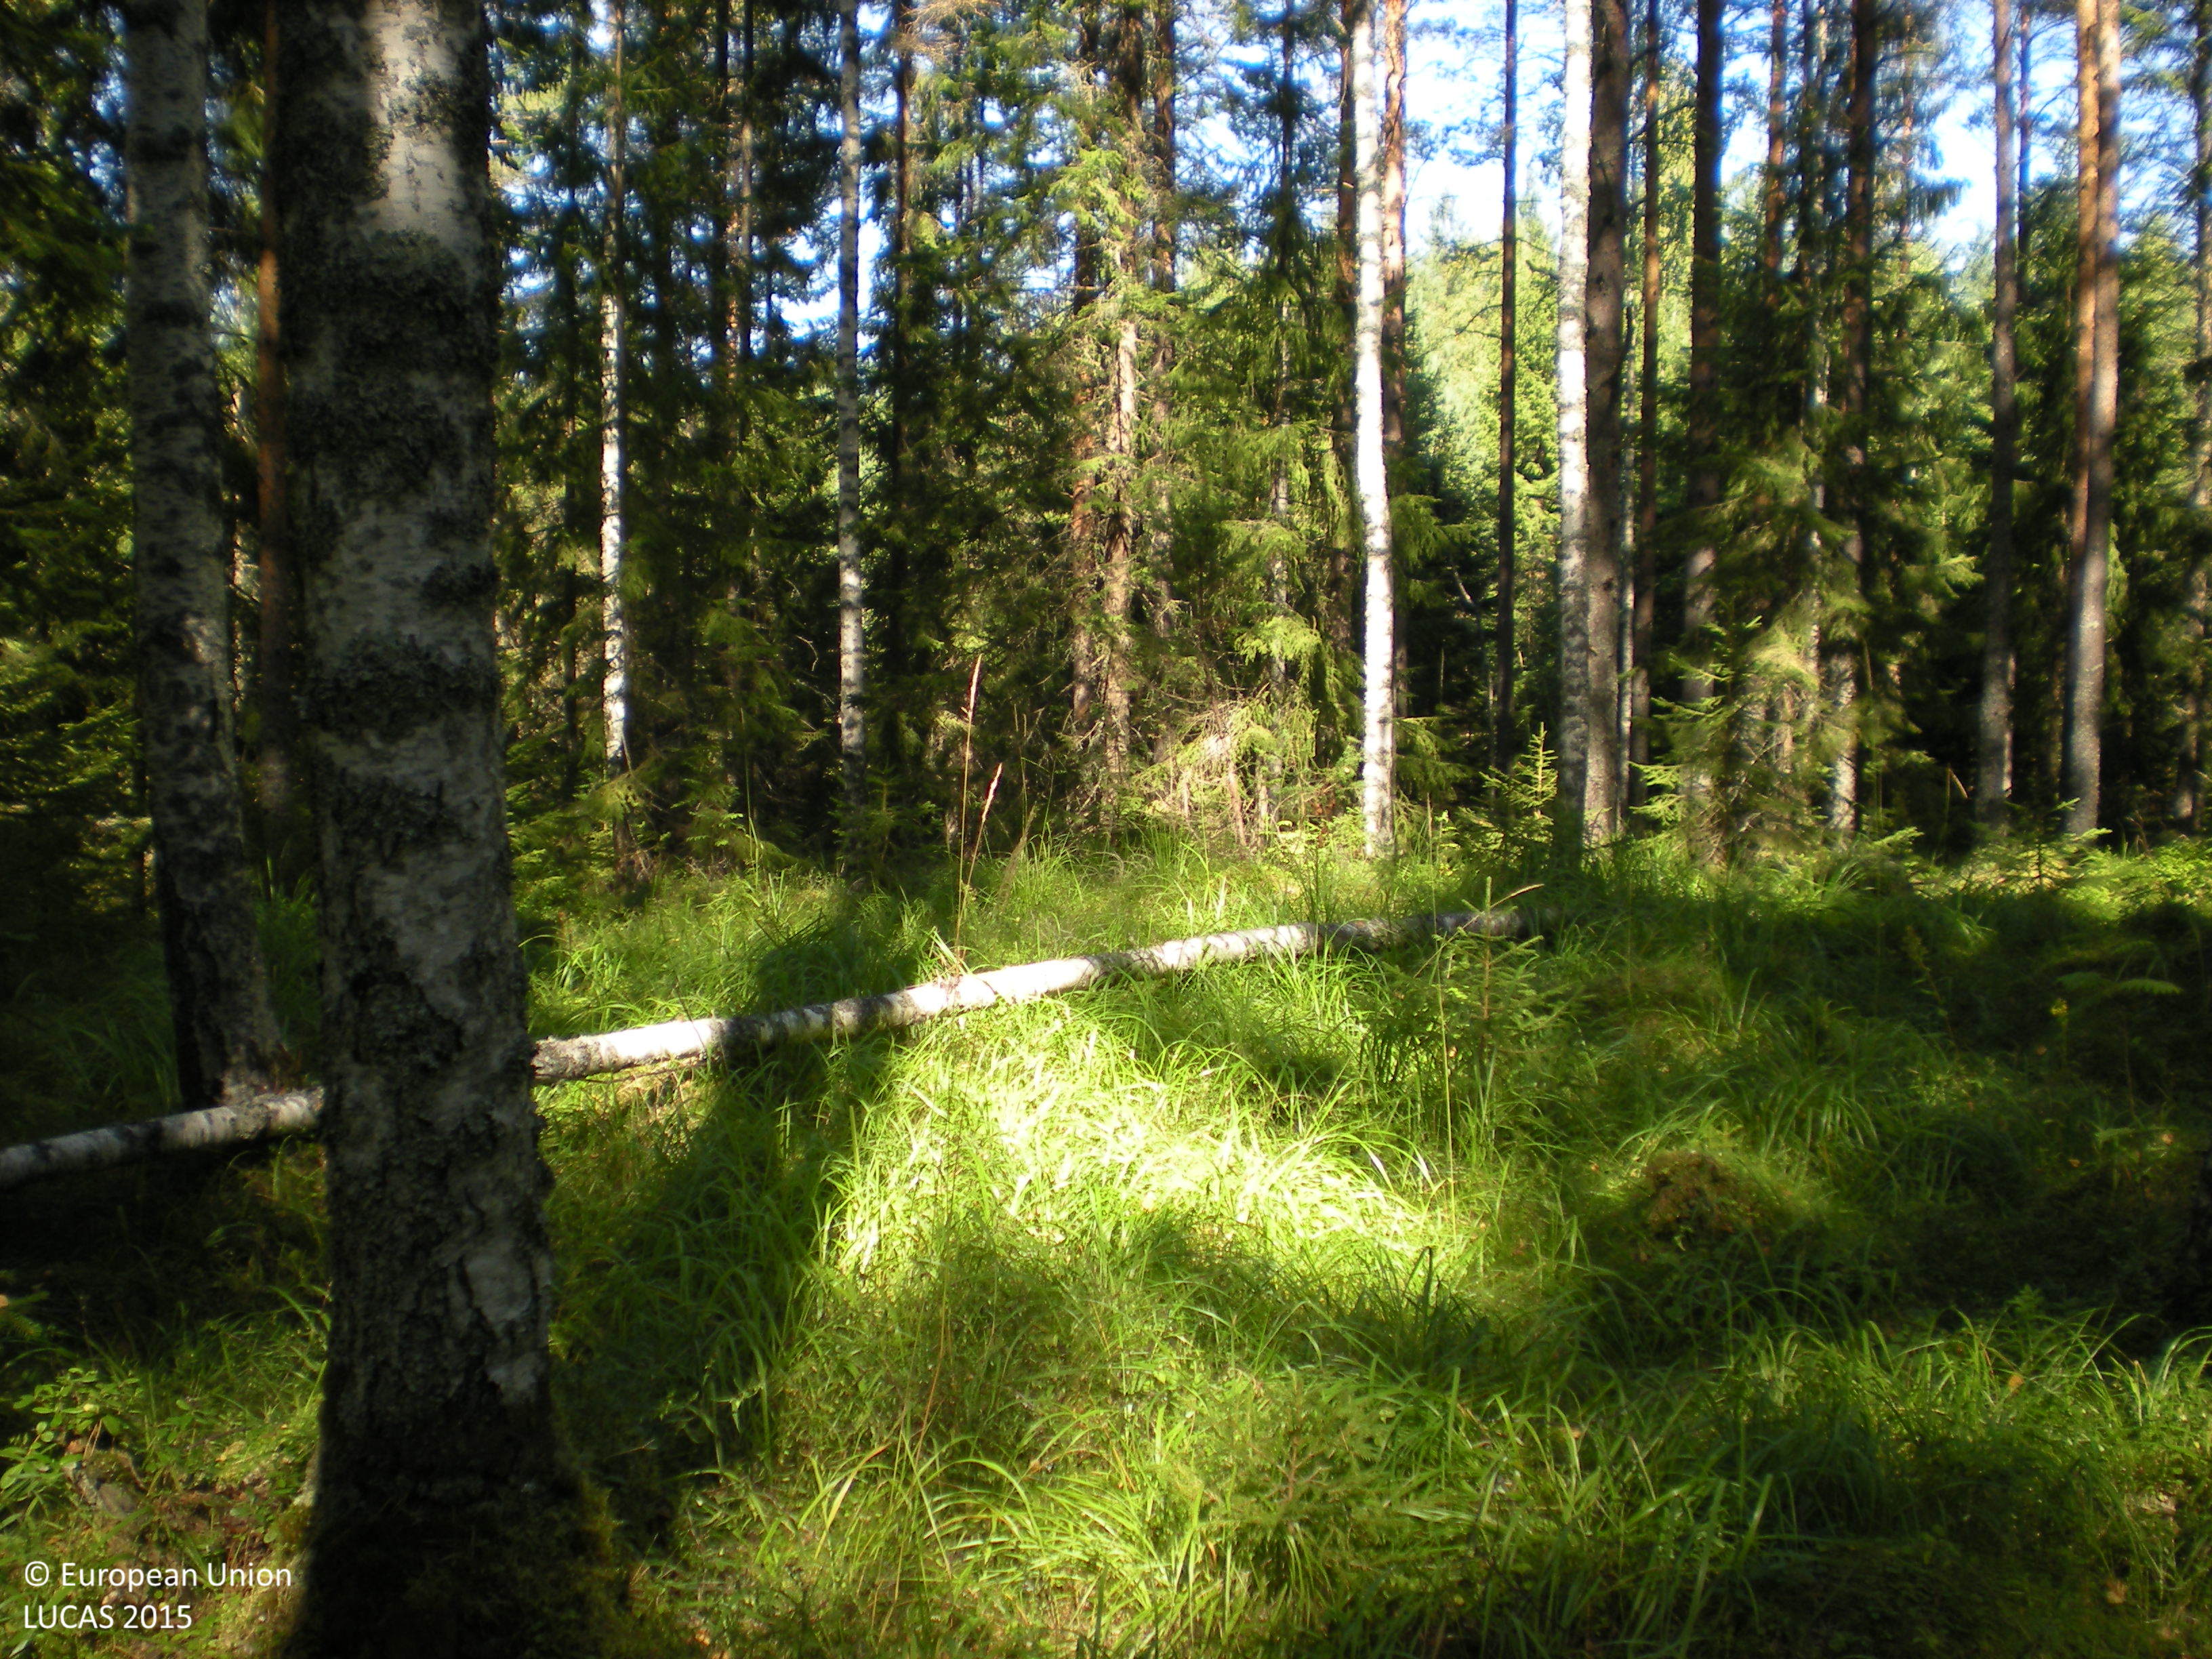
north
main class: Woodland
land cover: Pine dominated mixed woodland
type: boreal forest
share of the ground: 50 - 75 %
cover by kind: coniferous forest trees 50 %, broadleaved forest trees 20 %, herbaceous plants 15 %, shrubs 10 %, lichens and mosses 5 %
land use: Forestry
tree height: > 5 m
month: August
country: SE
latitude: 60.5990
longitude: 17.0929
